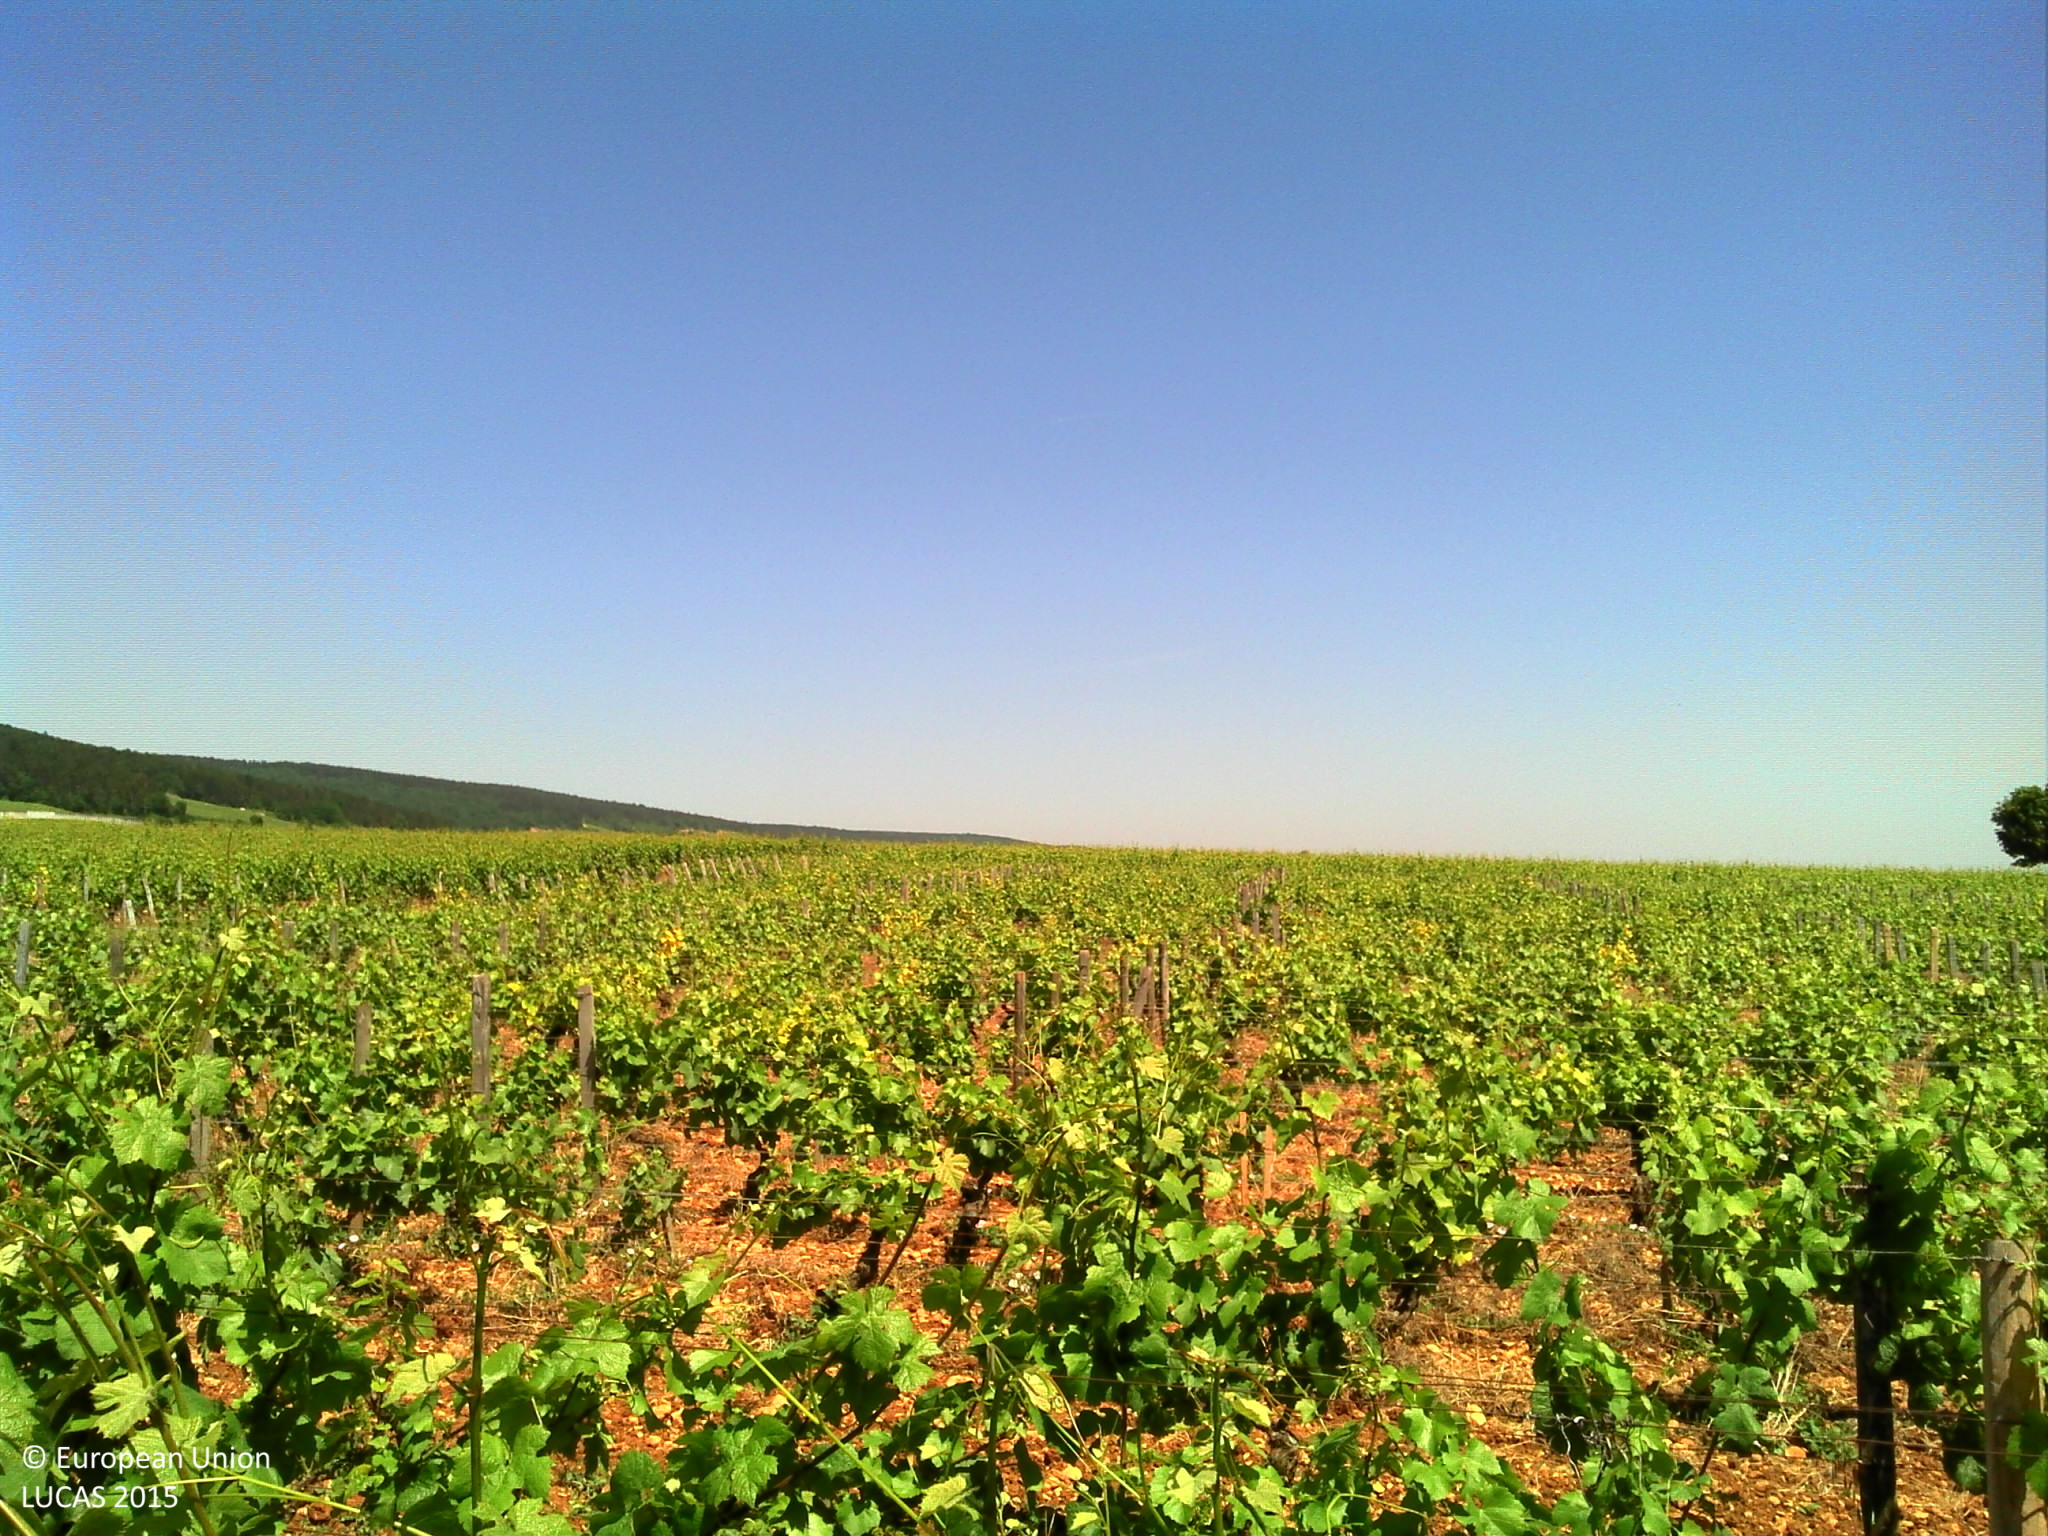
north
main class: Cropland
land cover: Vineyards
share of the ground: 50 - 75 %
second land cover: Other bare soil
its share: > 75 %
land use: Agriculture (excluding fallow land and kitchen gardens)
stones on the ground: > 50 %
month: June
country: FR
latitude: 47.2071
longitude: 4.9706
